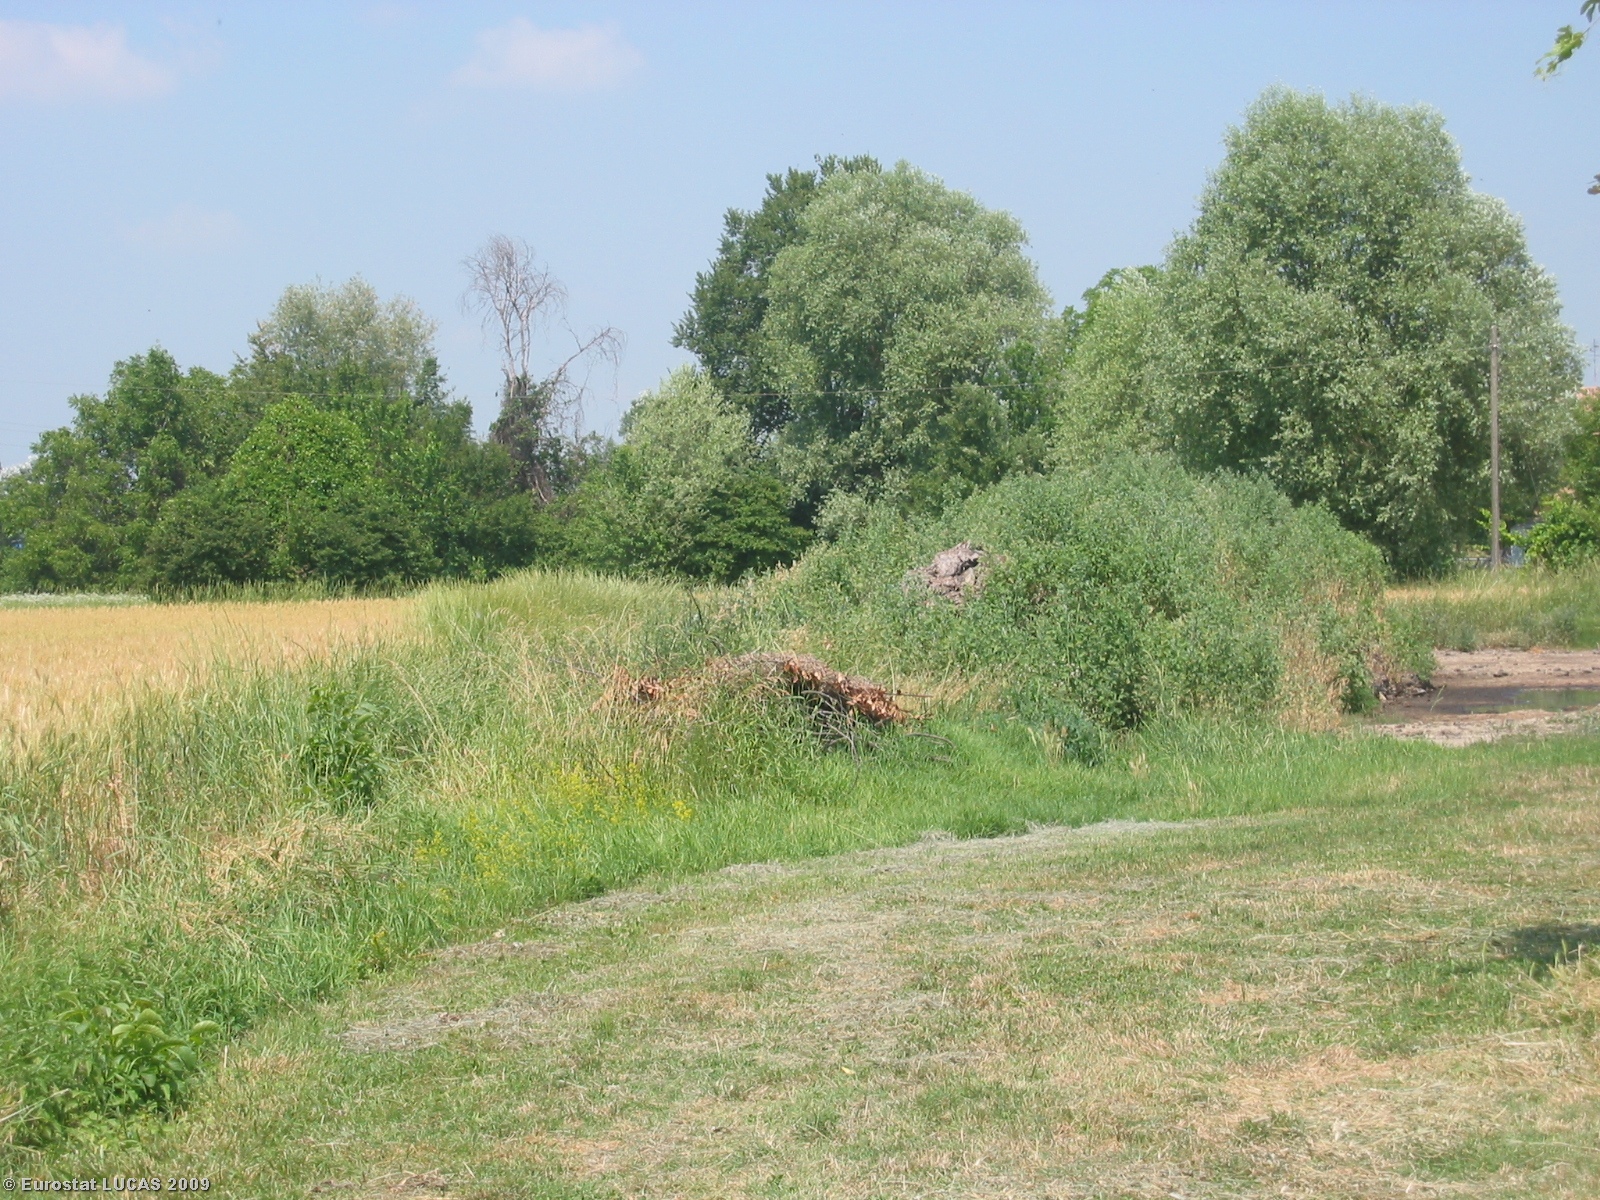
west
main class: Cropland
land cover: Common wheat
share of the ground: > 75 %
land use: Agriculture (excluding fallow land and kitchen gardens)
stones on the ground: < 10 %
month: June
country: IT
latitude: 44.7097
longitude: 10.5668
